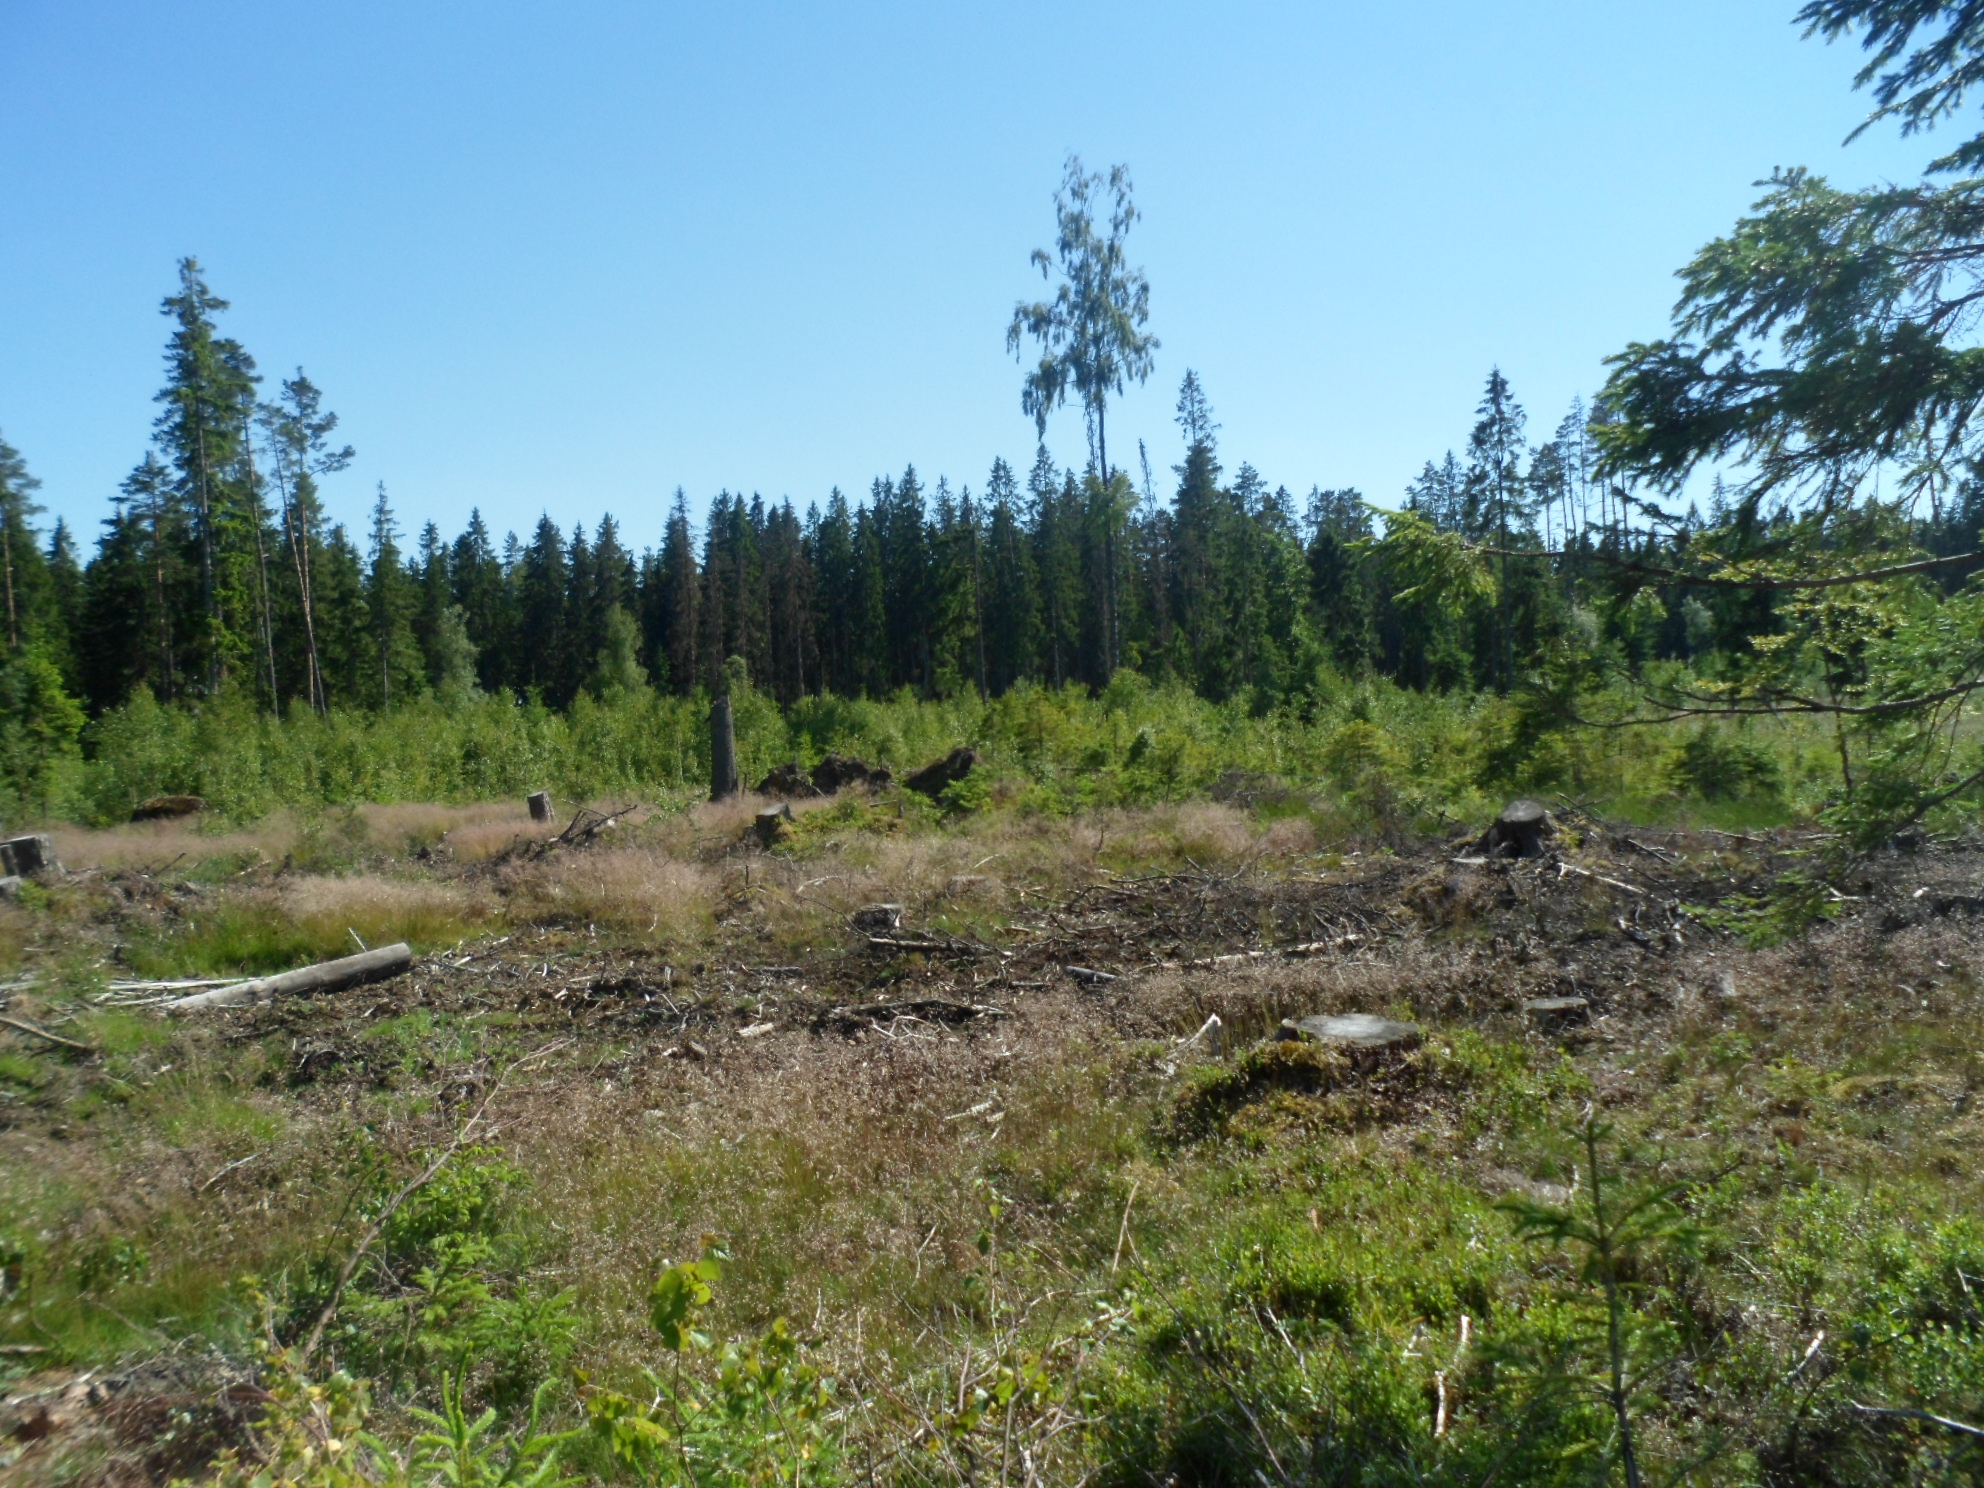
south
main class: Woodland
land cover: Spruce dominated mixed woodland
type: boreal forest
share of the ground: 10 - 25 %
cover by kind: herbaceous plants 40 %, shrubs 20 %, broadleaved forest trees 15 %, coniferous forest trees 10 %, lichens and mosses 10 %, unconsolidated bare surface 5 %
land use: Forestry
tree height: < 5 m
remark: Clear cut
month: July
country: SE
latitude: 57.1352
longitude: 14.5071
